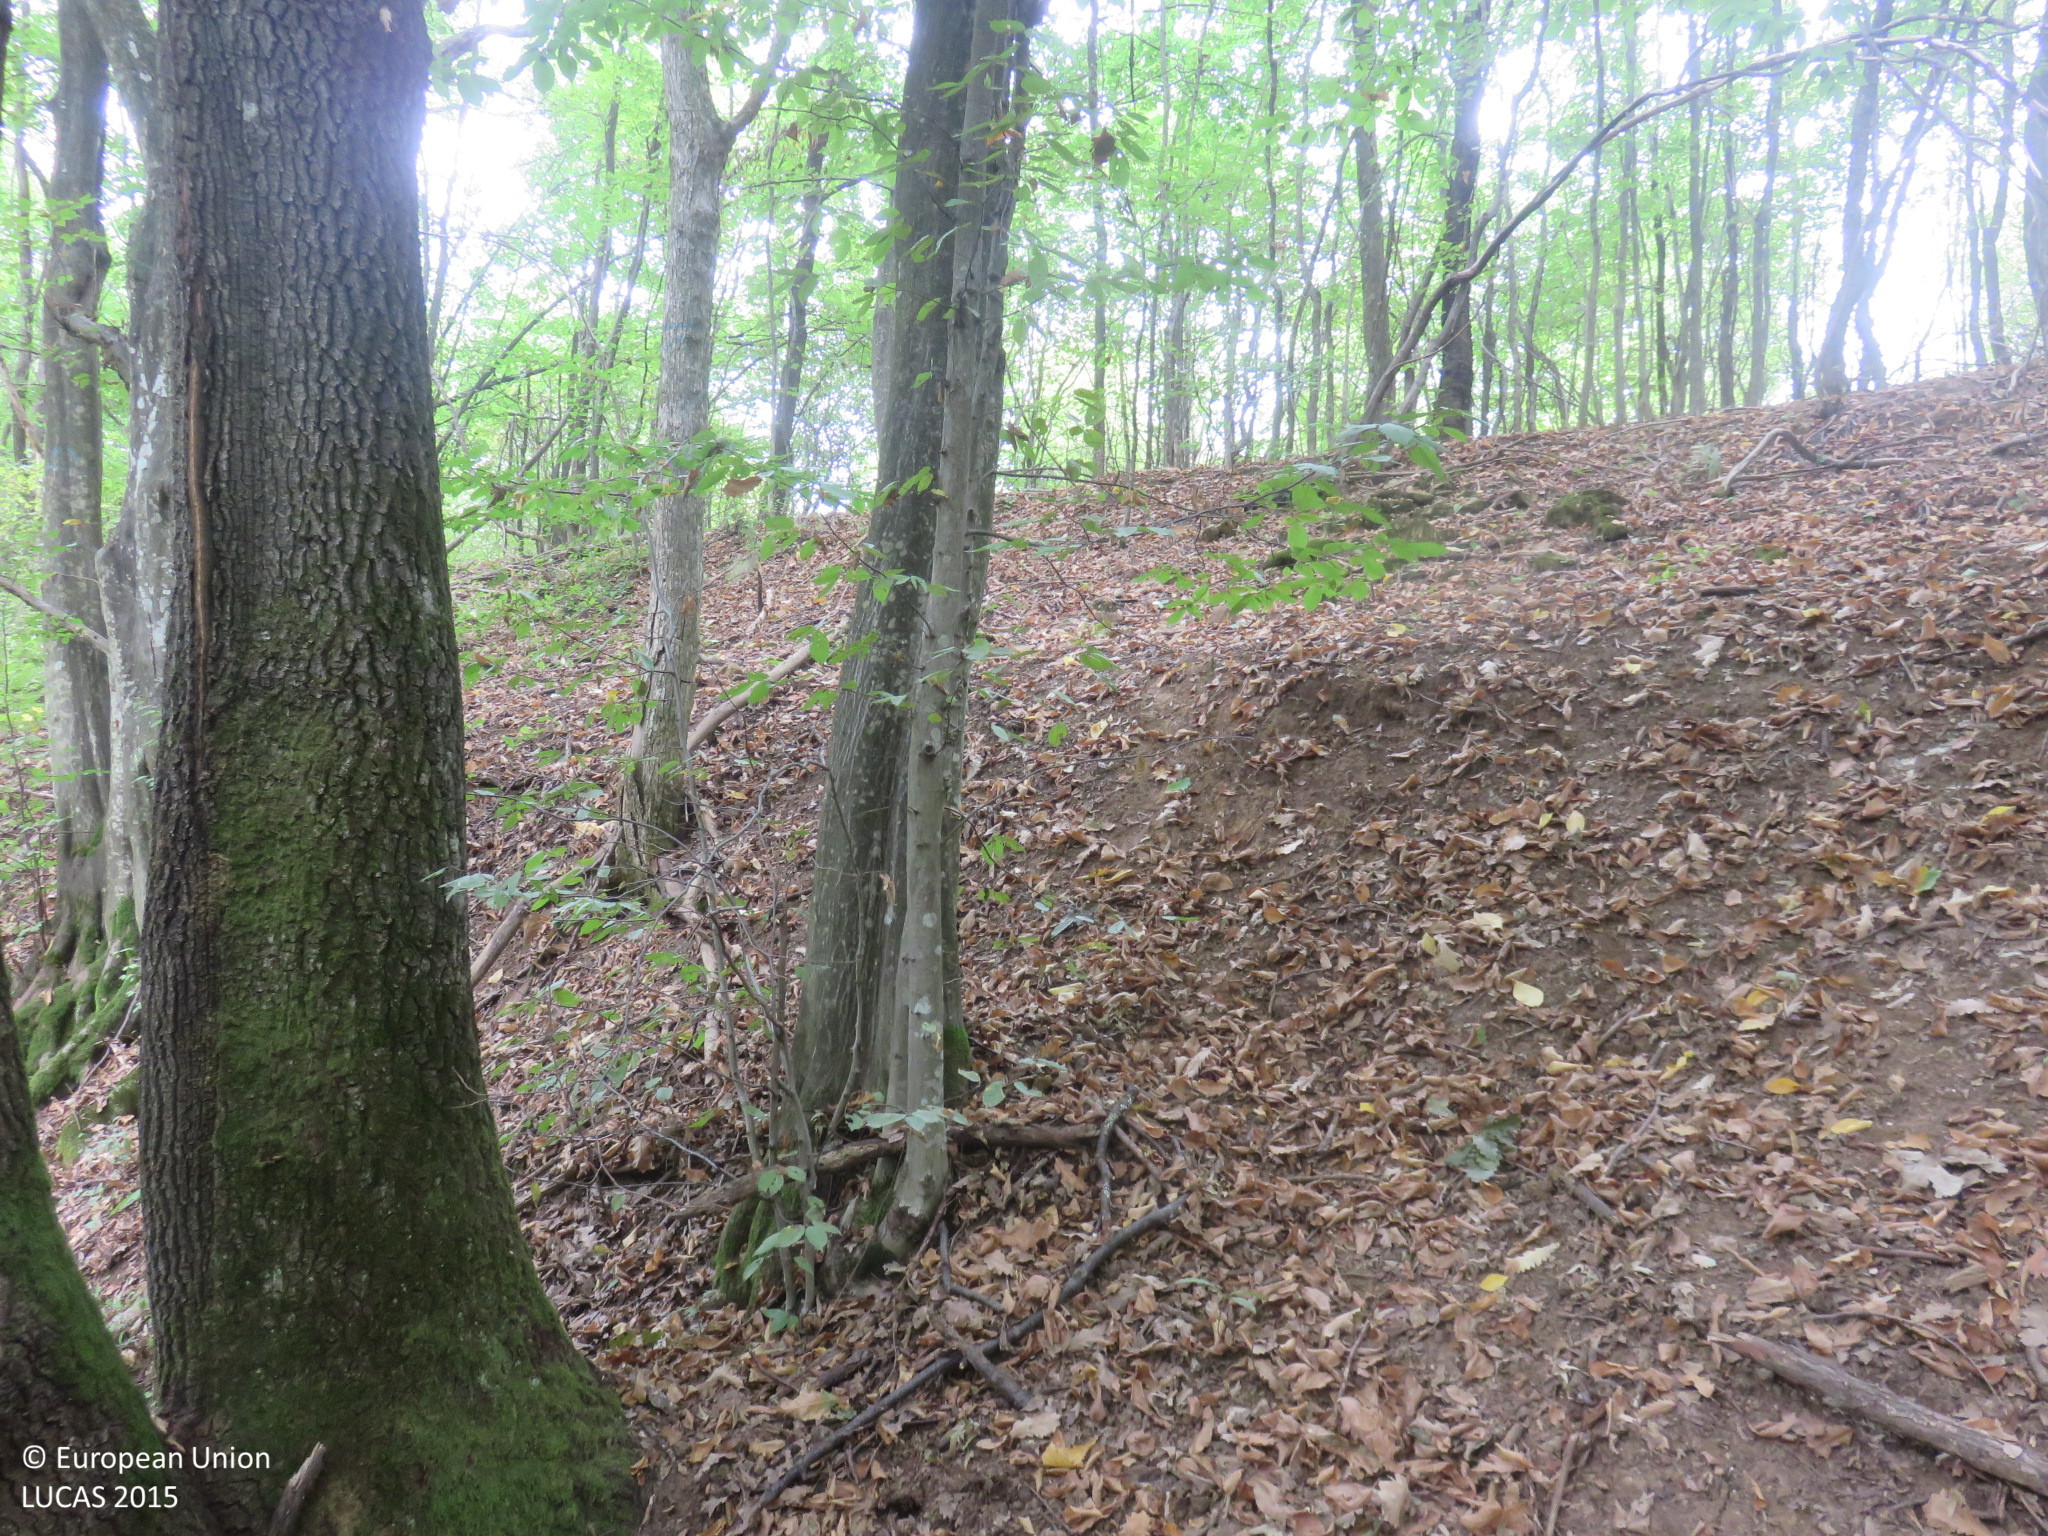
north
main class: Woodland
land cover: Broadleaved woodland
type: beech forest
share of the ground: > 75 %
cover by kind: broadleaved forest trees 85 %, unconsolidated bare surface 10 %, shrubs 5 %
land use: Forestry
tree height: > 5 m
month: September
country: BG
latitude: 43.0929
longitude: 24.8430
